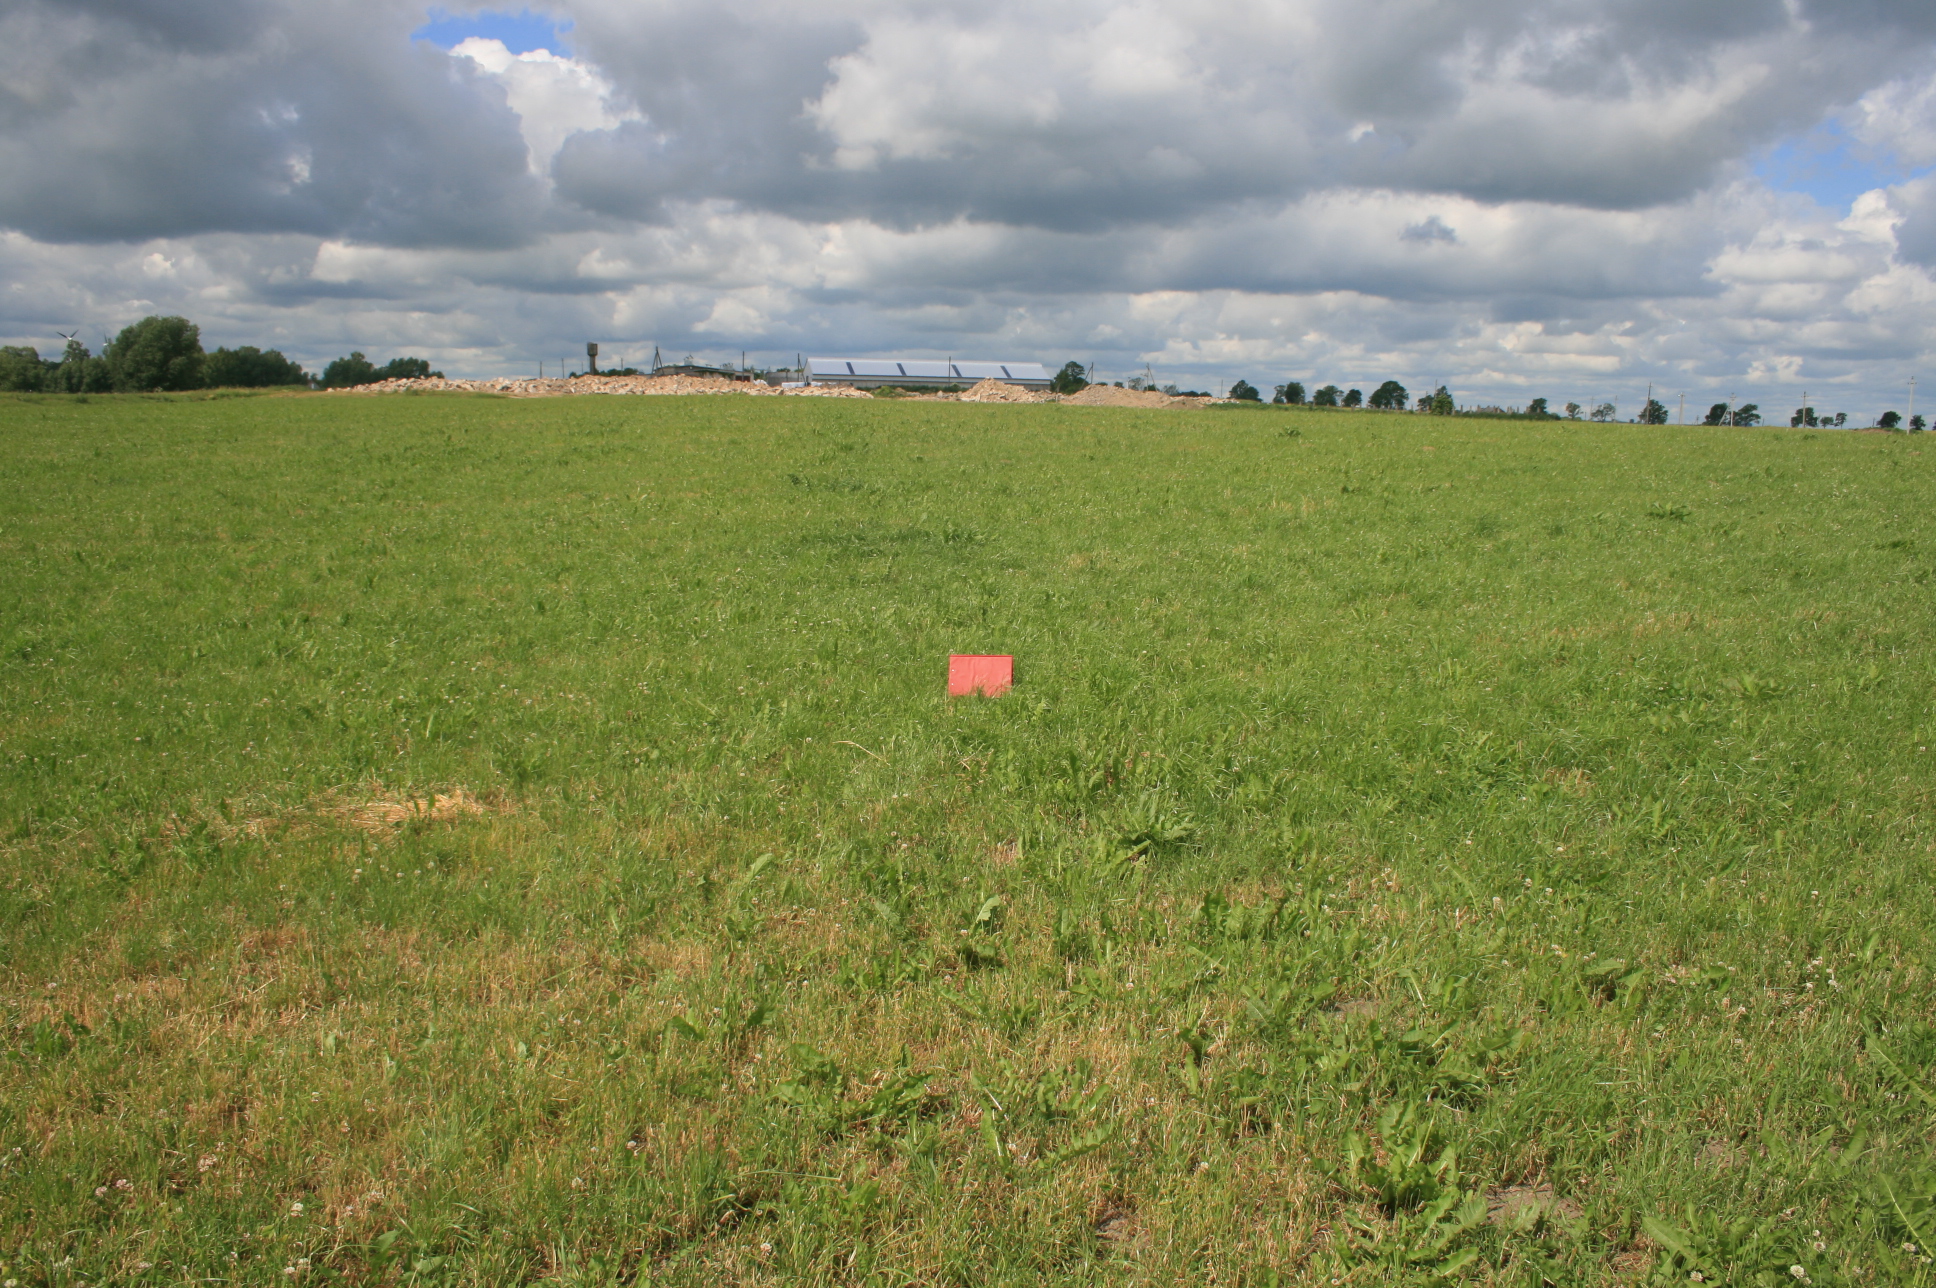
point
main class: Grassland
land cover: Grassland without tree/shrub cover
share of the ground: > 75 %
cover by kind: herbaceous plants 100 %
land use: Agriculture (excluding fallow land and kitchen gardens)
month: June
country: LT
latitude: 55.2143
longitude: 22.0786
